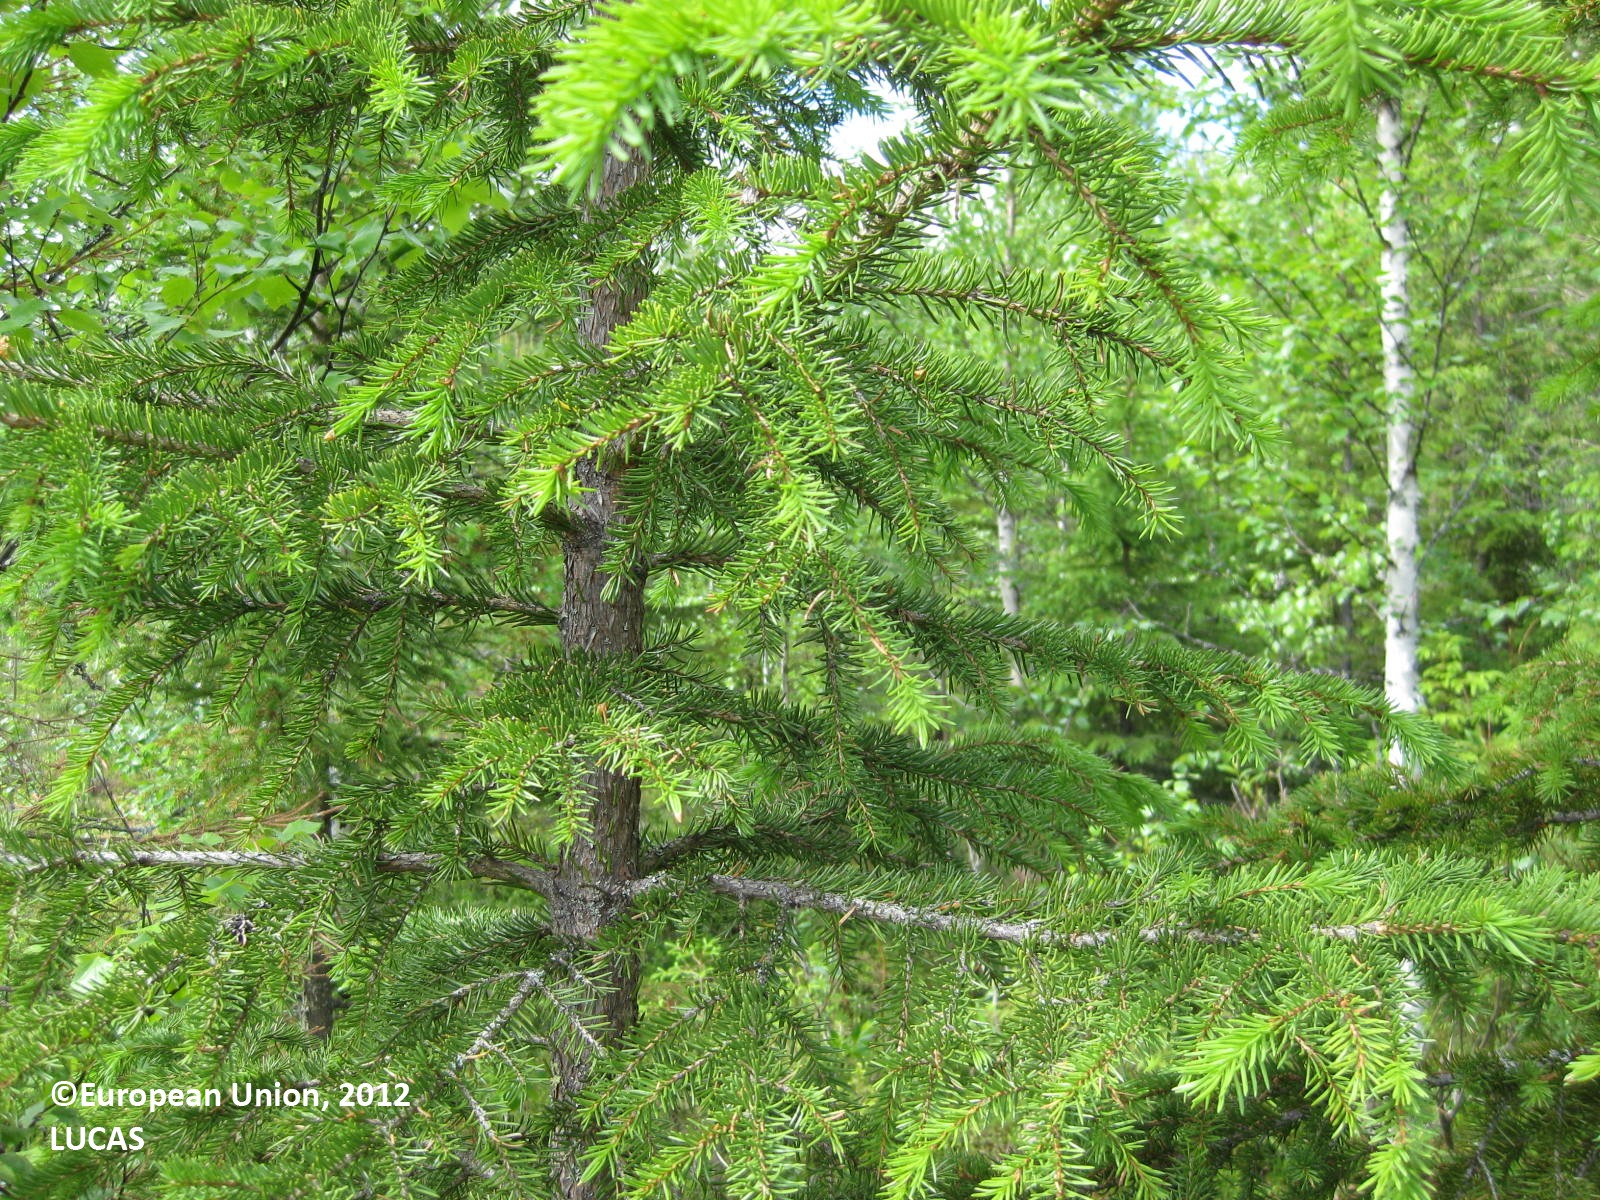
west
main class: Woodland
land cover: Spruce dominated mixed woodland
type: boreal forest
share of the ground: 50 - 75 %
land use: Forestry
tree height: > 5 m
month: June
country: FI
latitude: 65.3523
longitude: 28.3165
